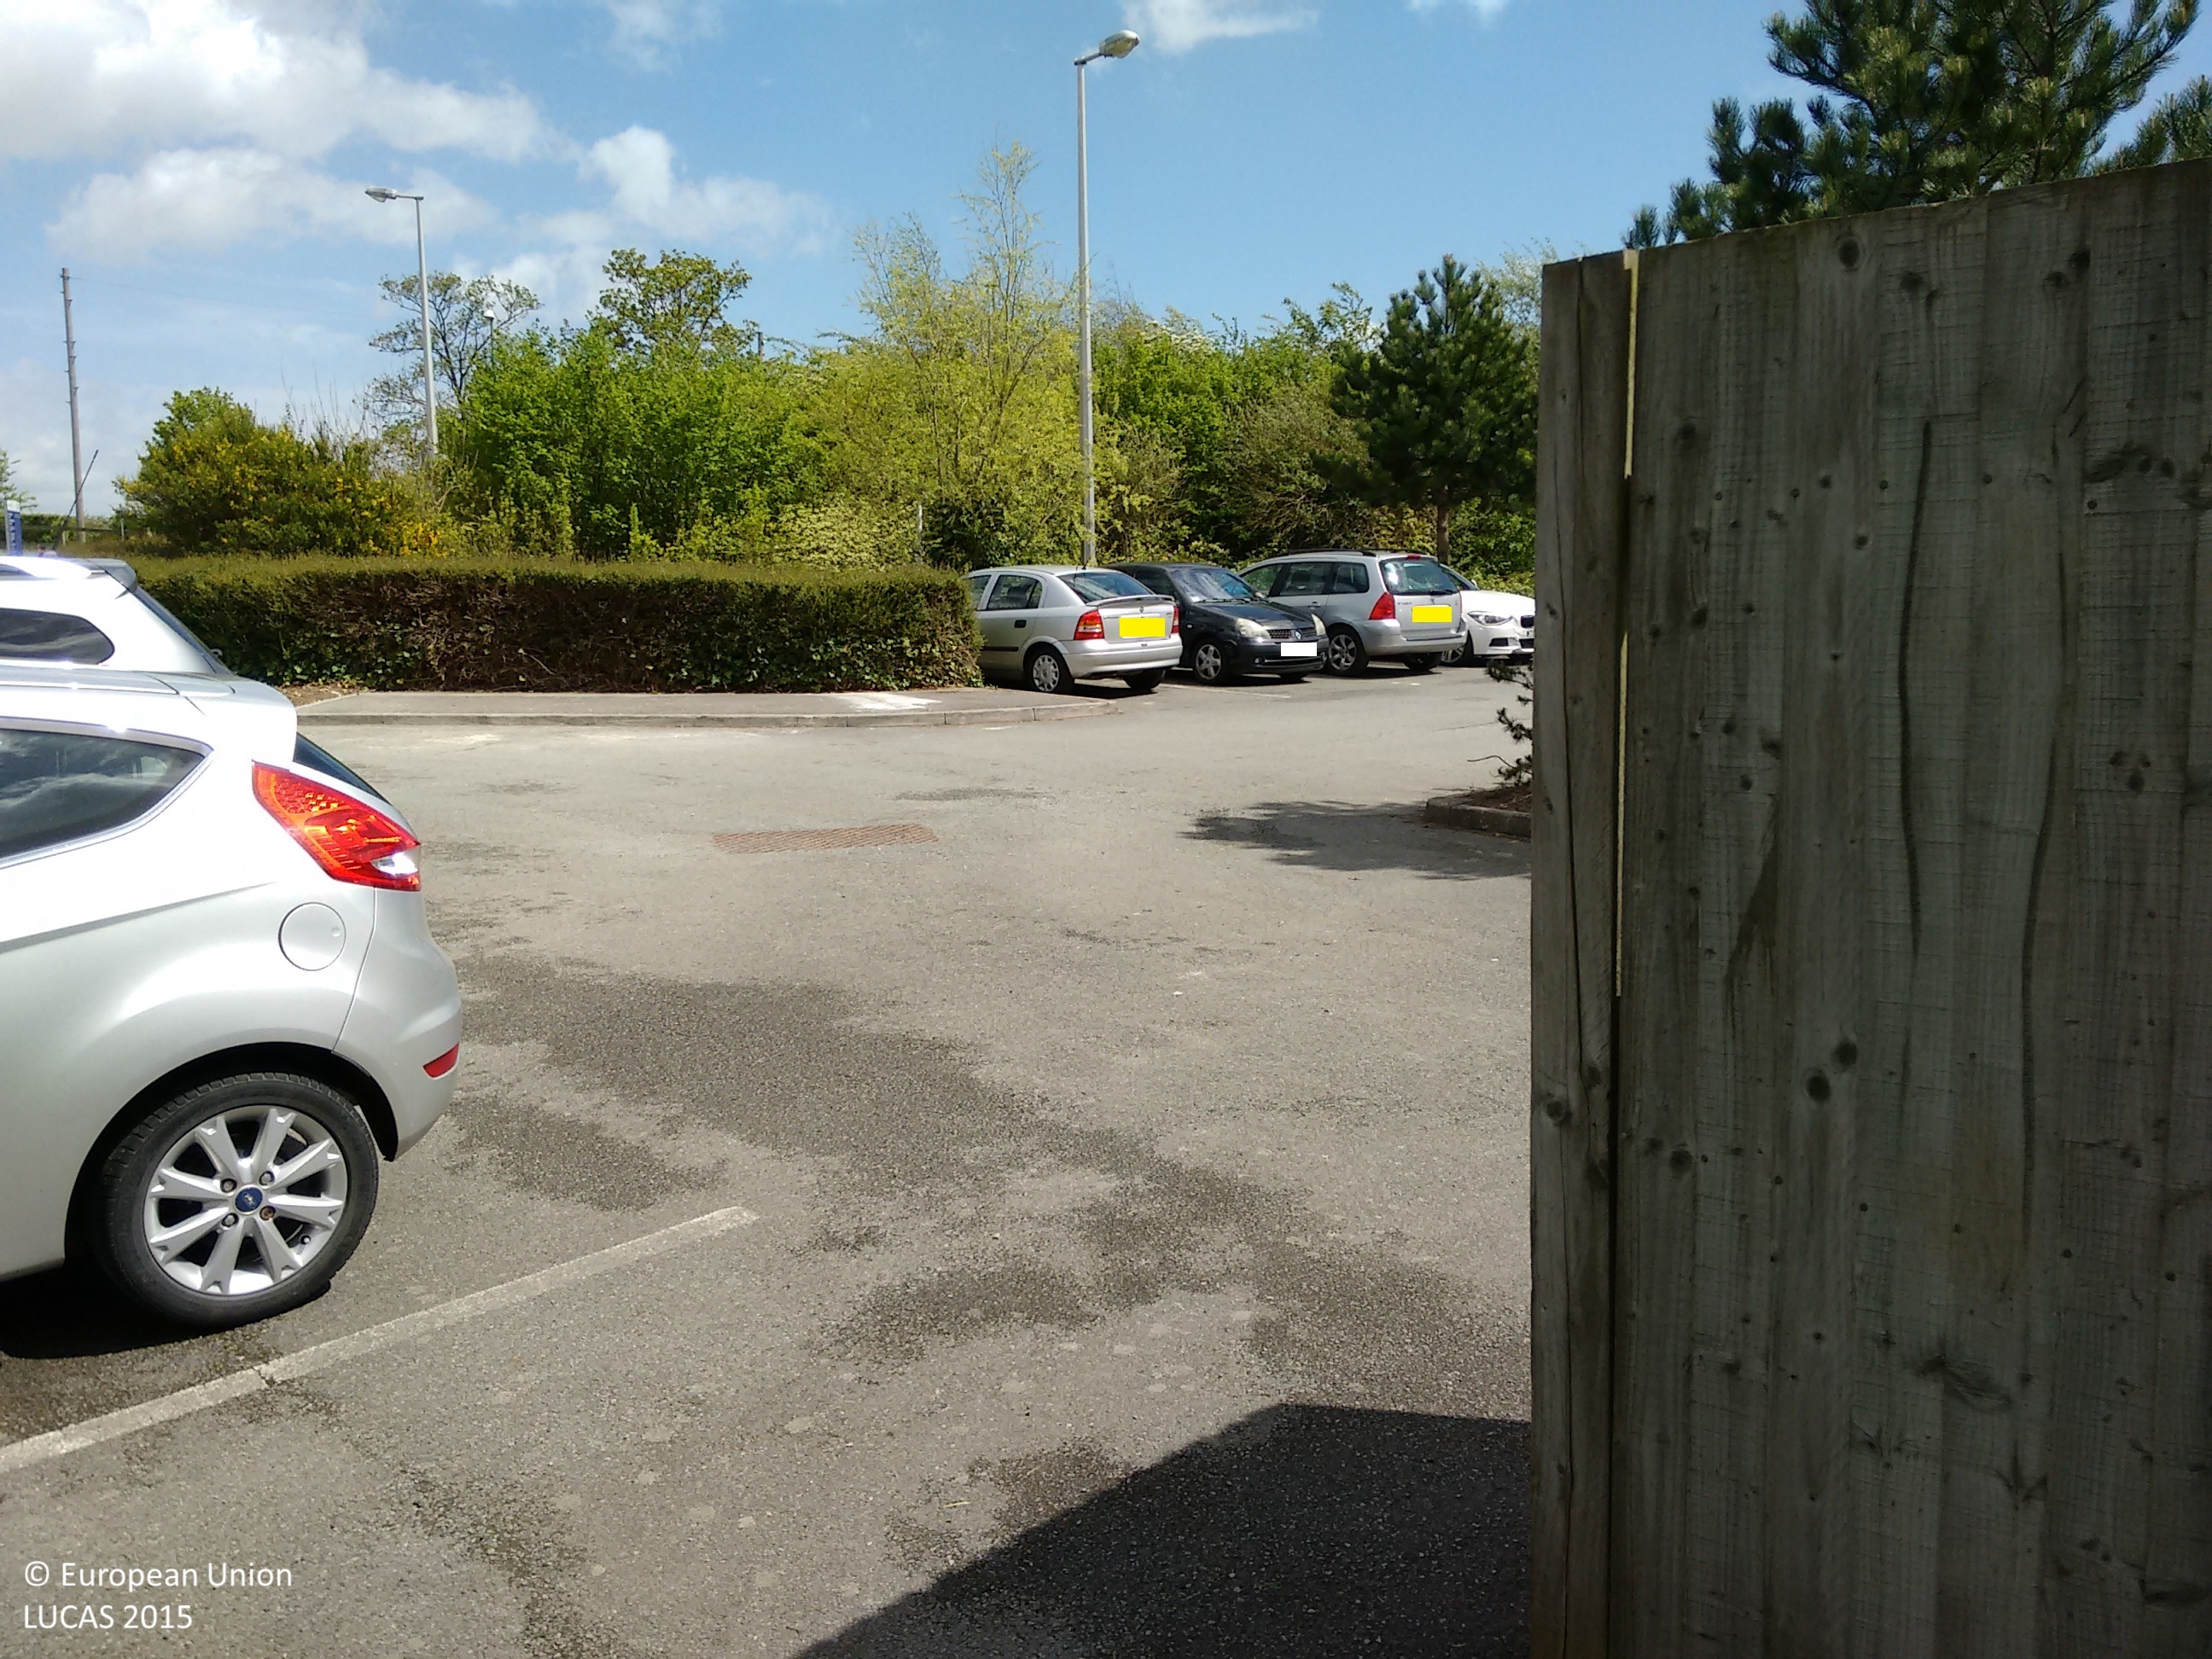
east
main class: Grassland
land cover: Grassland with sparse tree/shrub cover
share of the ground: > 75 %
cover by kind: herbaceous plants 95 %, coniferous forest trees 5 %
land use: Residential
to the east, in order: Grassland with sparse tree/shrub cover; Artificial constructions in urban areas; Managed hedges; Rape and turnip rape
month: May
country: GB
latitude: 51.4327
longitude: 0.2604
